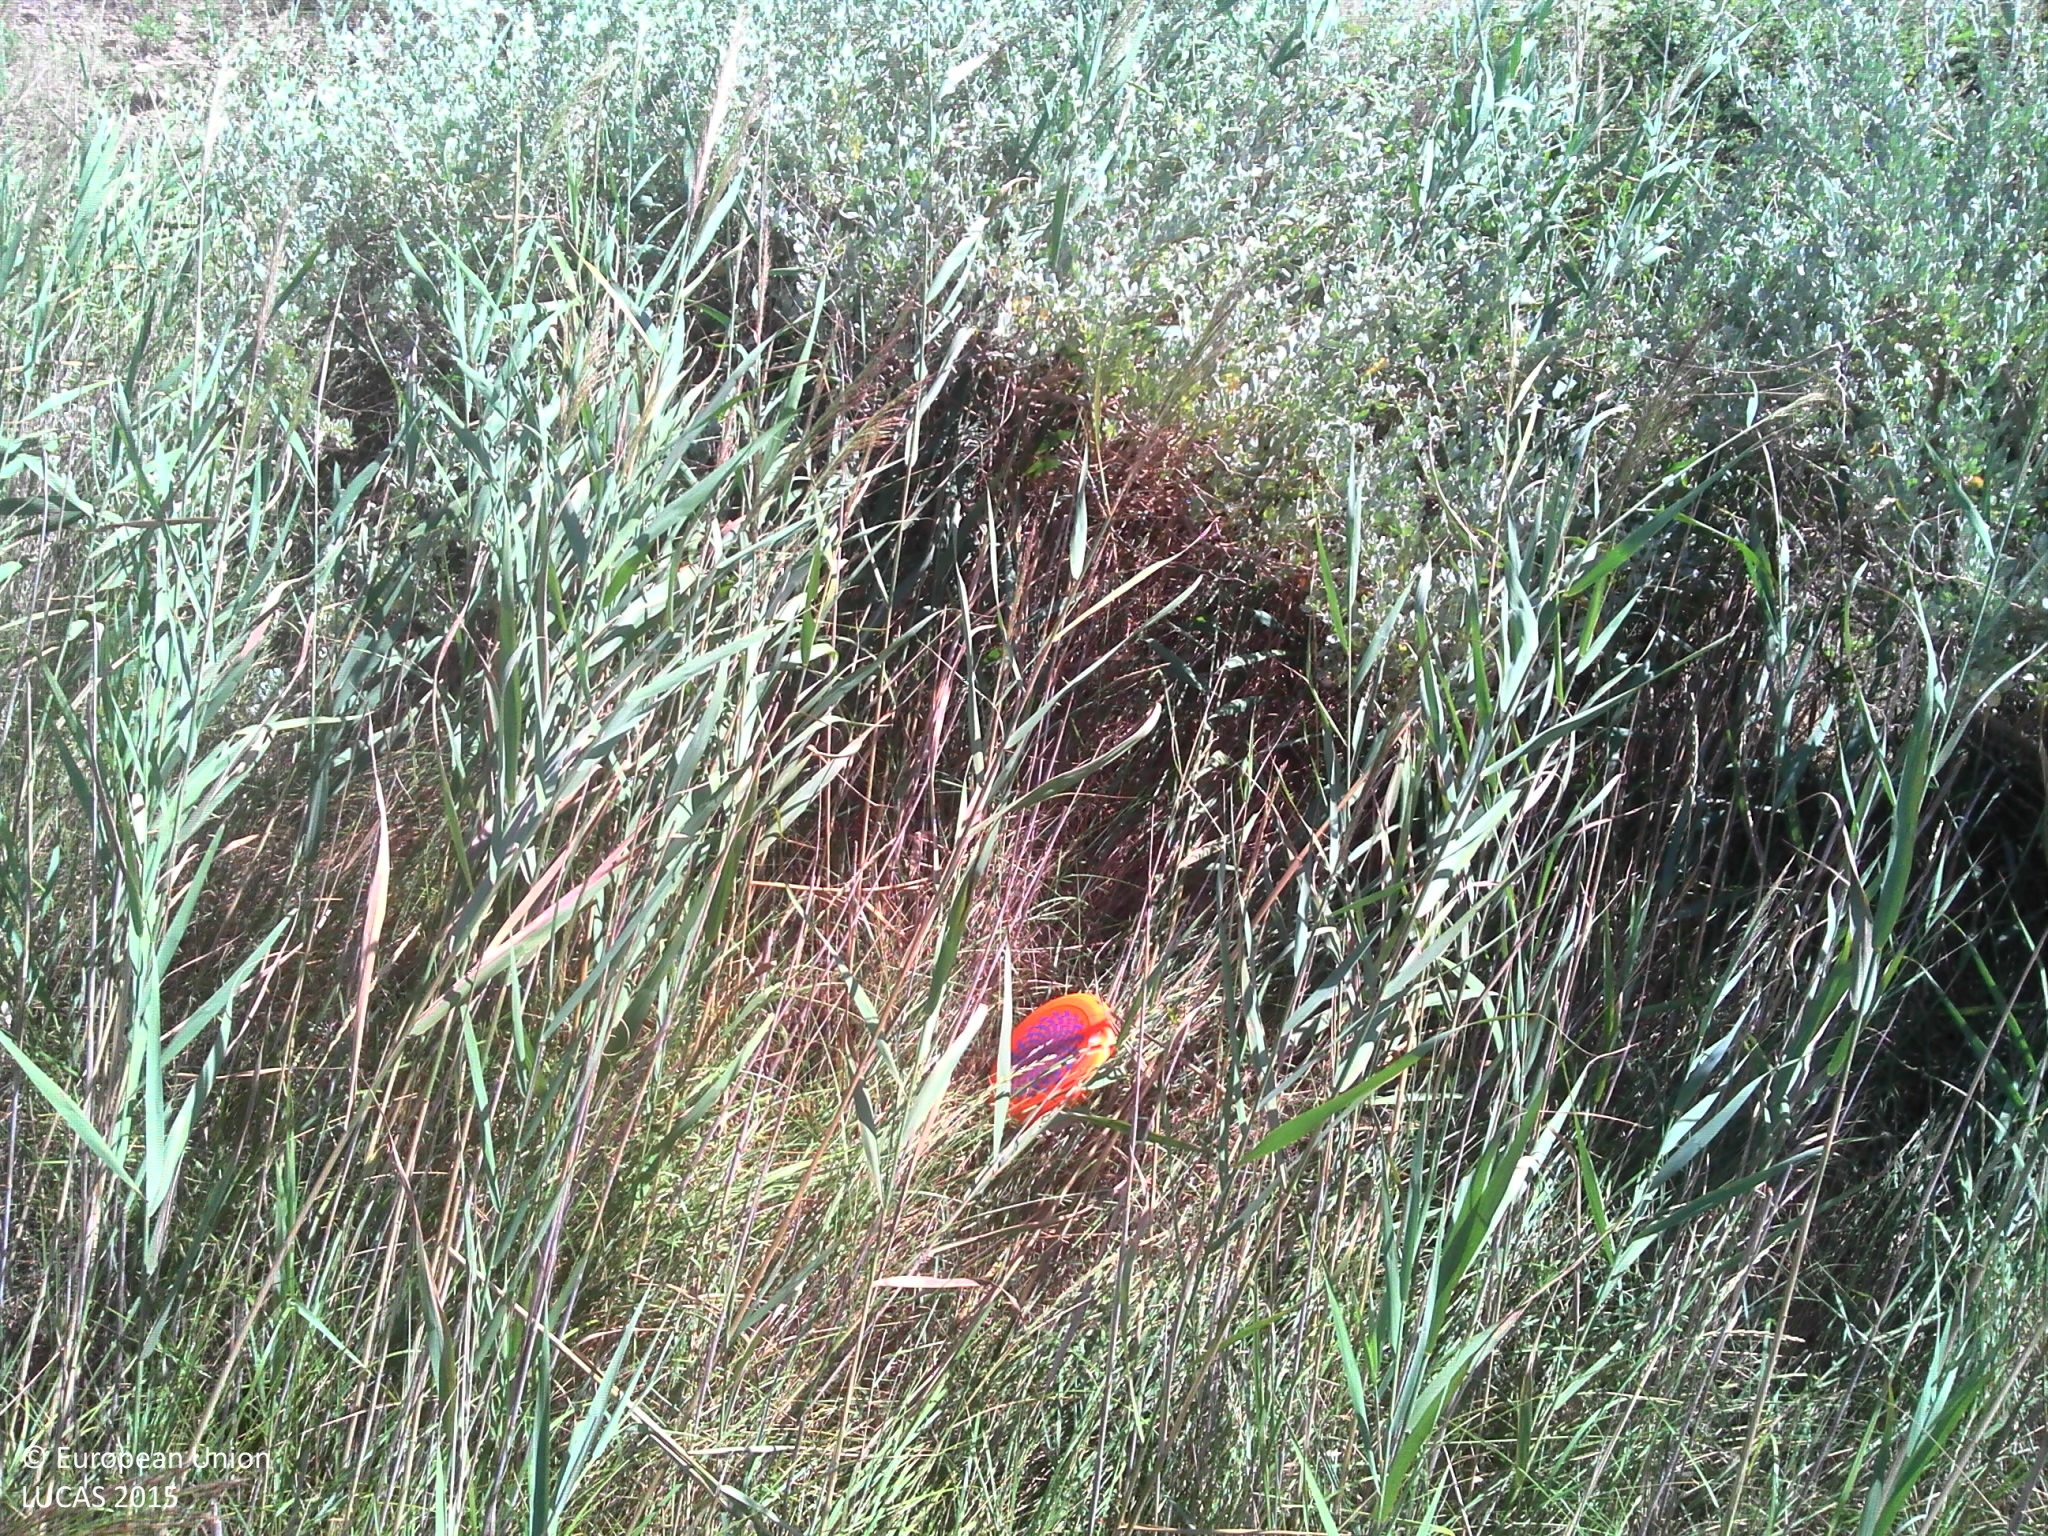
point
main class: Grassland
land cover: Spontaneously vegetated surfaces
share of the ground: > 75 %
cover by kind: herbaceous plants 55 %, consolidated bare surface 20 %, unconsolidated bare surface 20 %, shrubs 5 %
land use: Energy production
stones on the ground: 10 - 25 %
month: July
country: FR
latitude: 43.4421
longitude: 4.7838
